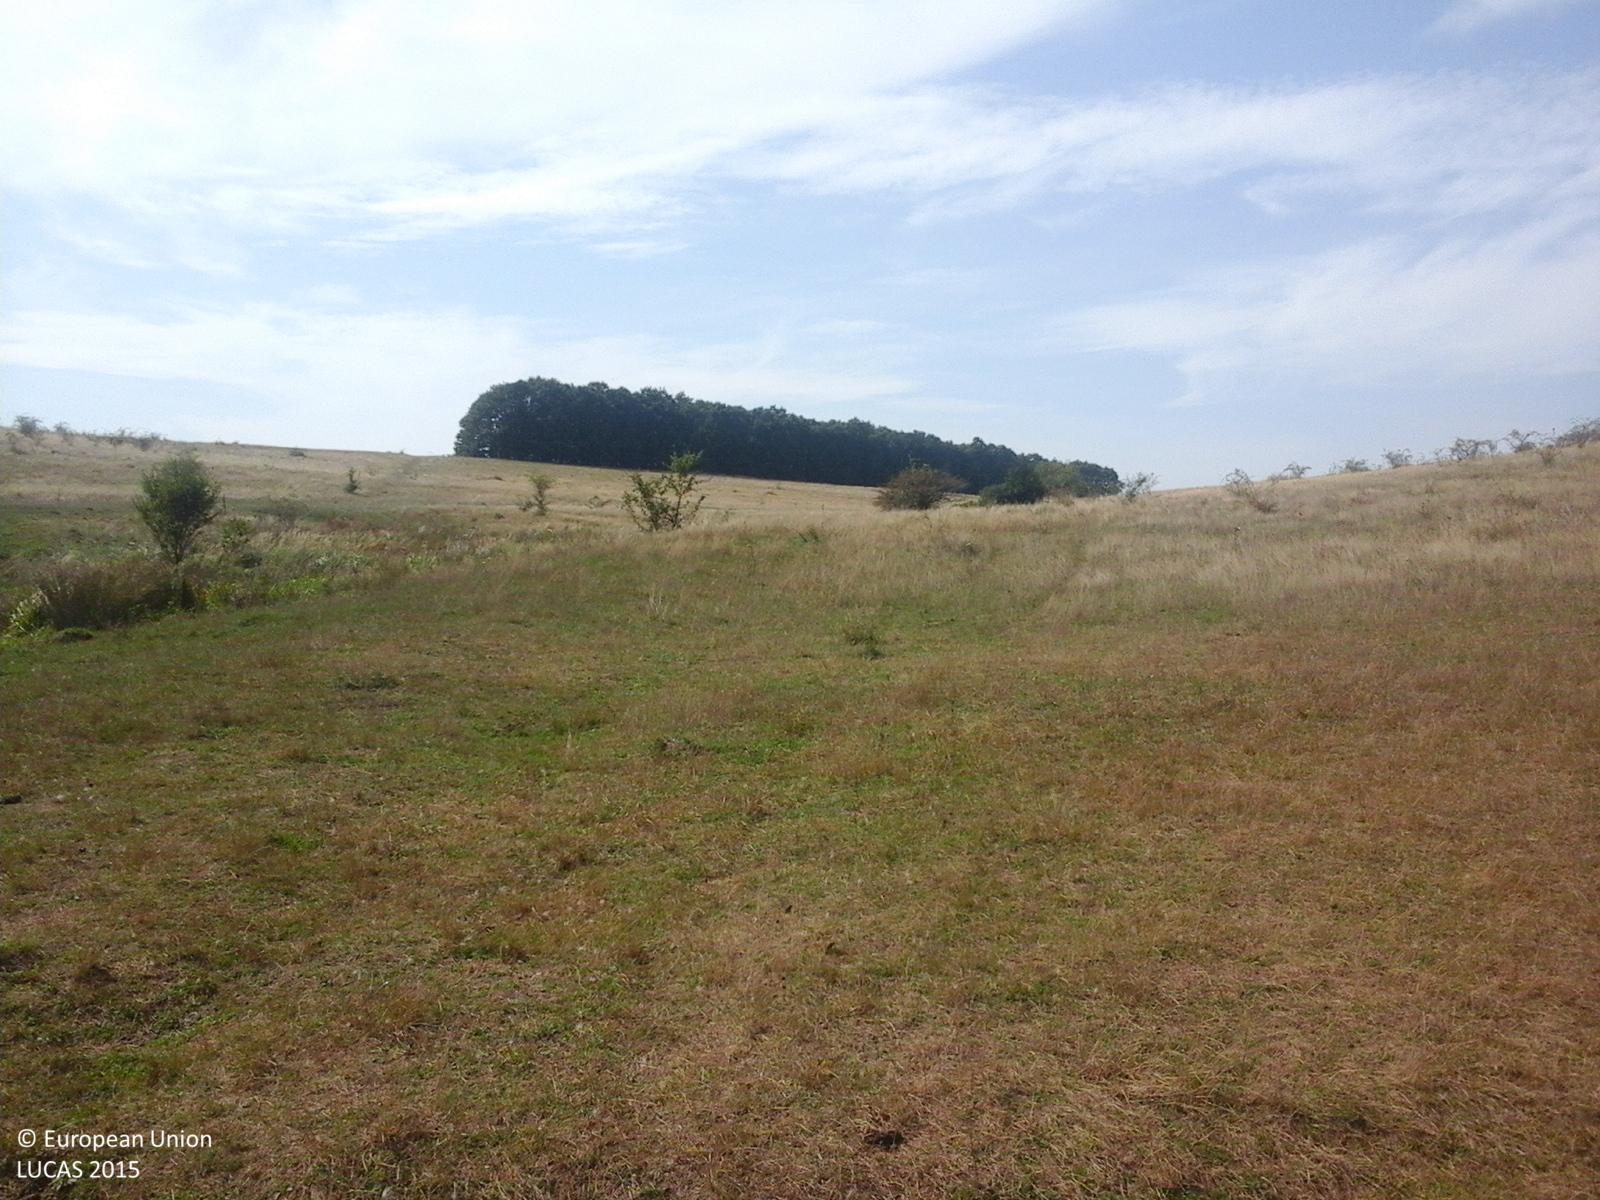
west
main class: Grassland
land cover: Grassland without tree/shrub cover
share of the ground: > 75 %
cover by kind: herbaceous plants 100 %
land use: Agriculture (excluding fallow land and kitchen gardens)
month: September
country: RO
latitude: 47.1179
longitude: 23.4753
